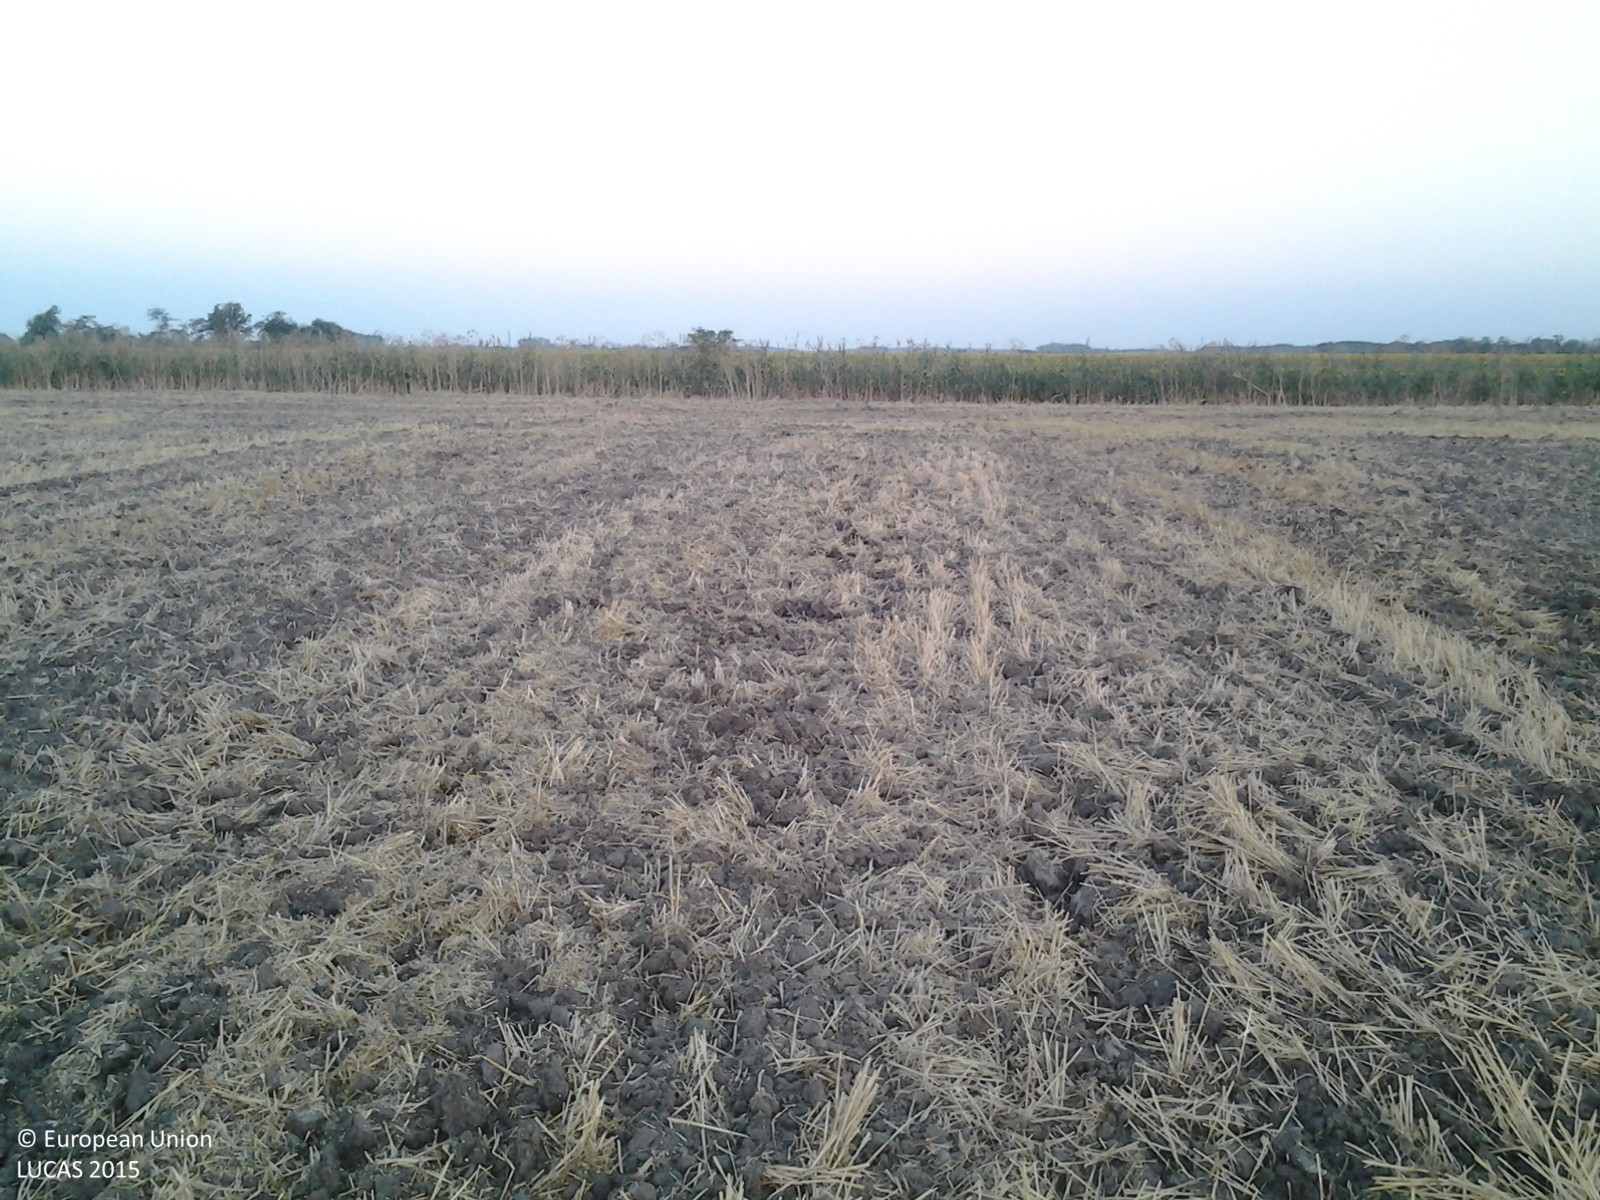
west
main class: Cropland
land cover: Common wheat
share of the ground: > 75 %
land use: Agriculture (excluding fallow land and kitchen gardens)
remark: Harvested field
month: July
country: HU
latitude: 47.0617
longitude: 20.9222
